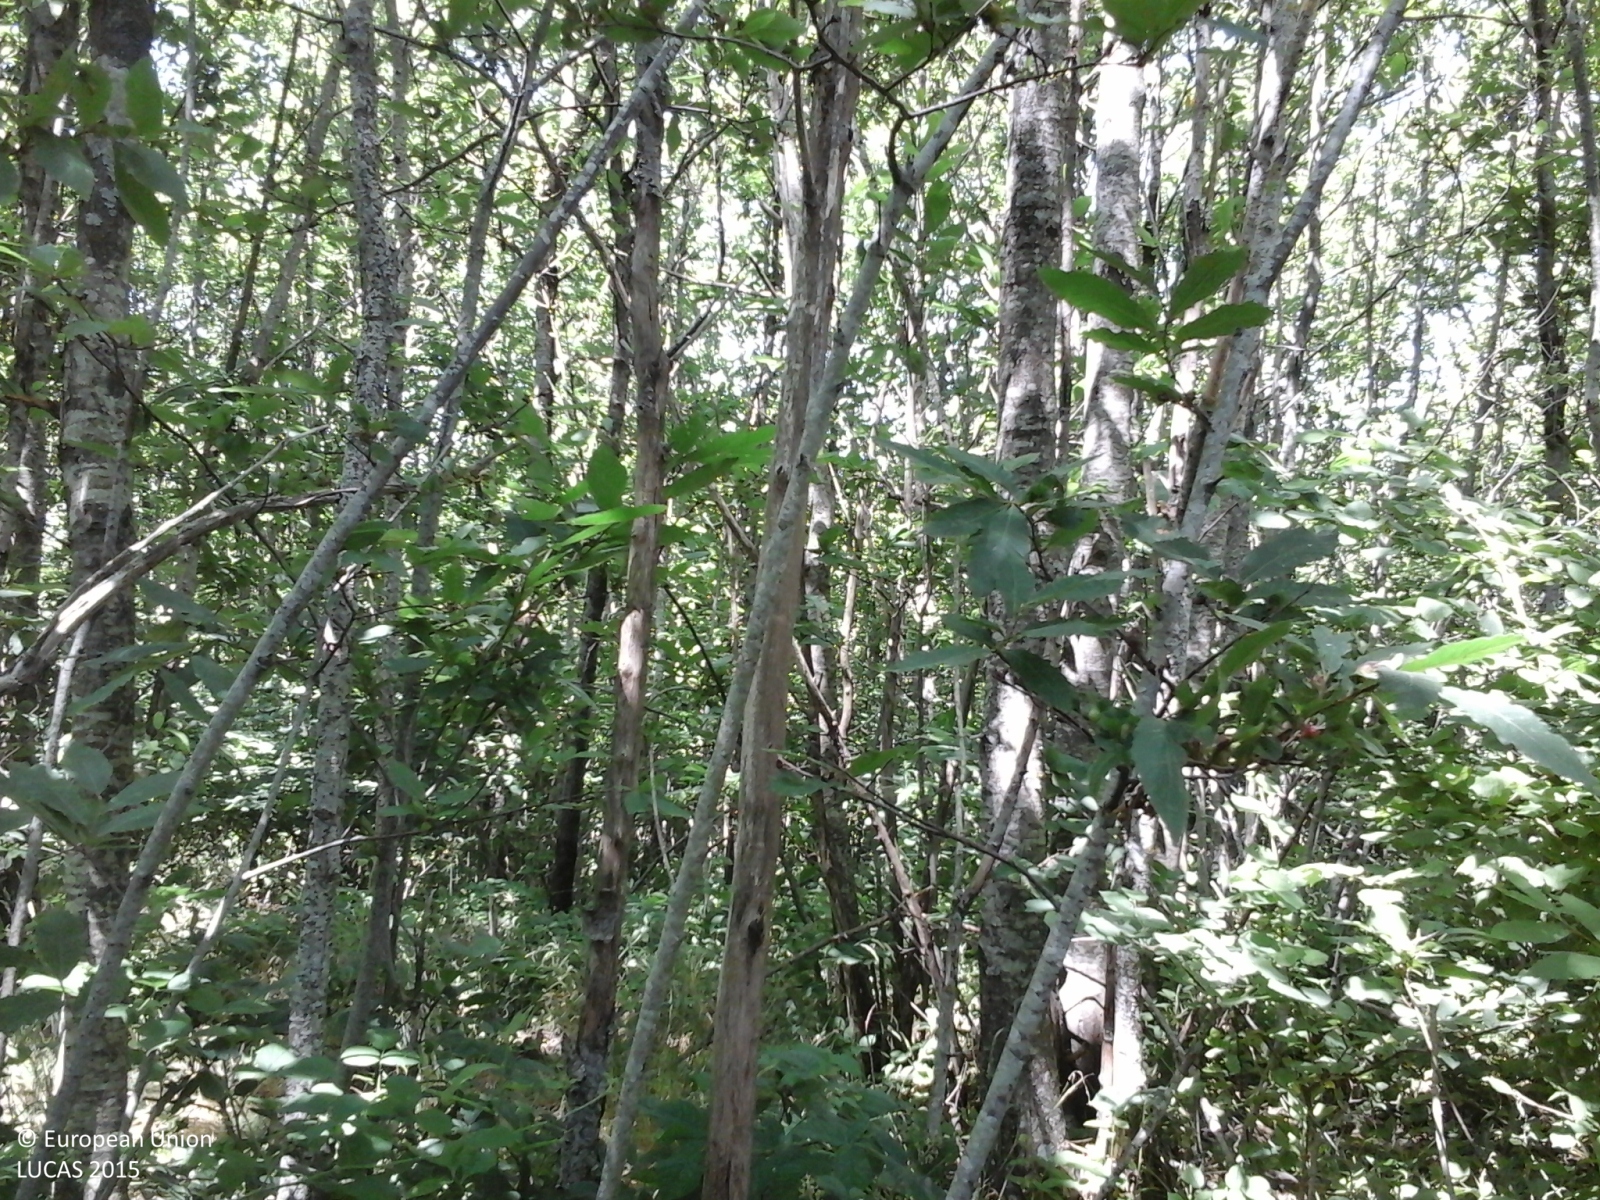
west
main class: Woodland
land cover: Broadleaved woodland
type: thermophilous deciduous forest
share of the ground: > 75 %
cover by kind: broadleaved forest trees 80 %, shrubs 20 %
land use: Forestry
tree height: > 5 m
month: July
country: IT
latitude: 40.8799
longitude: 14.6923
